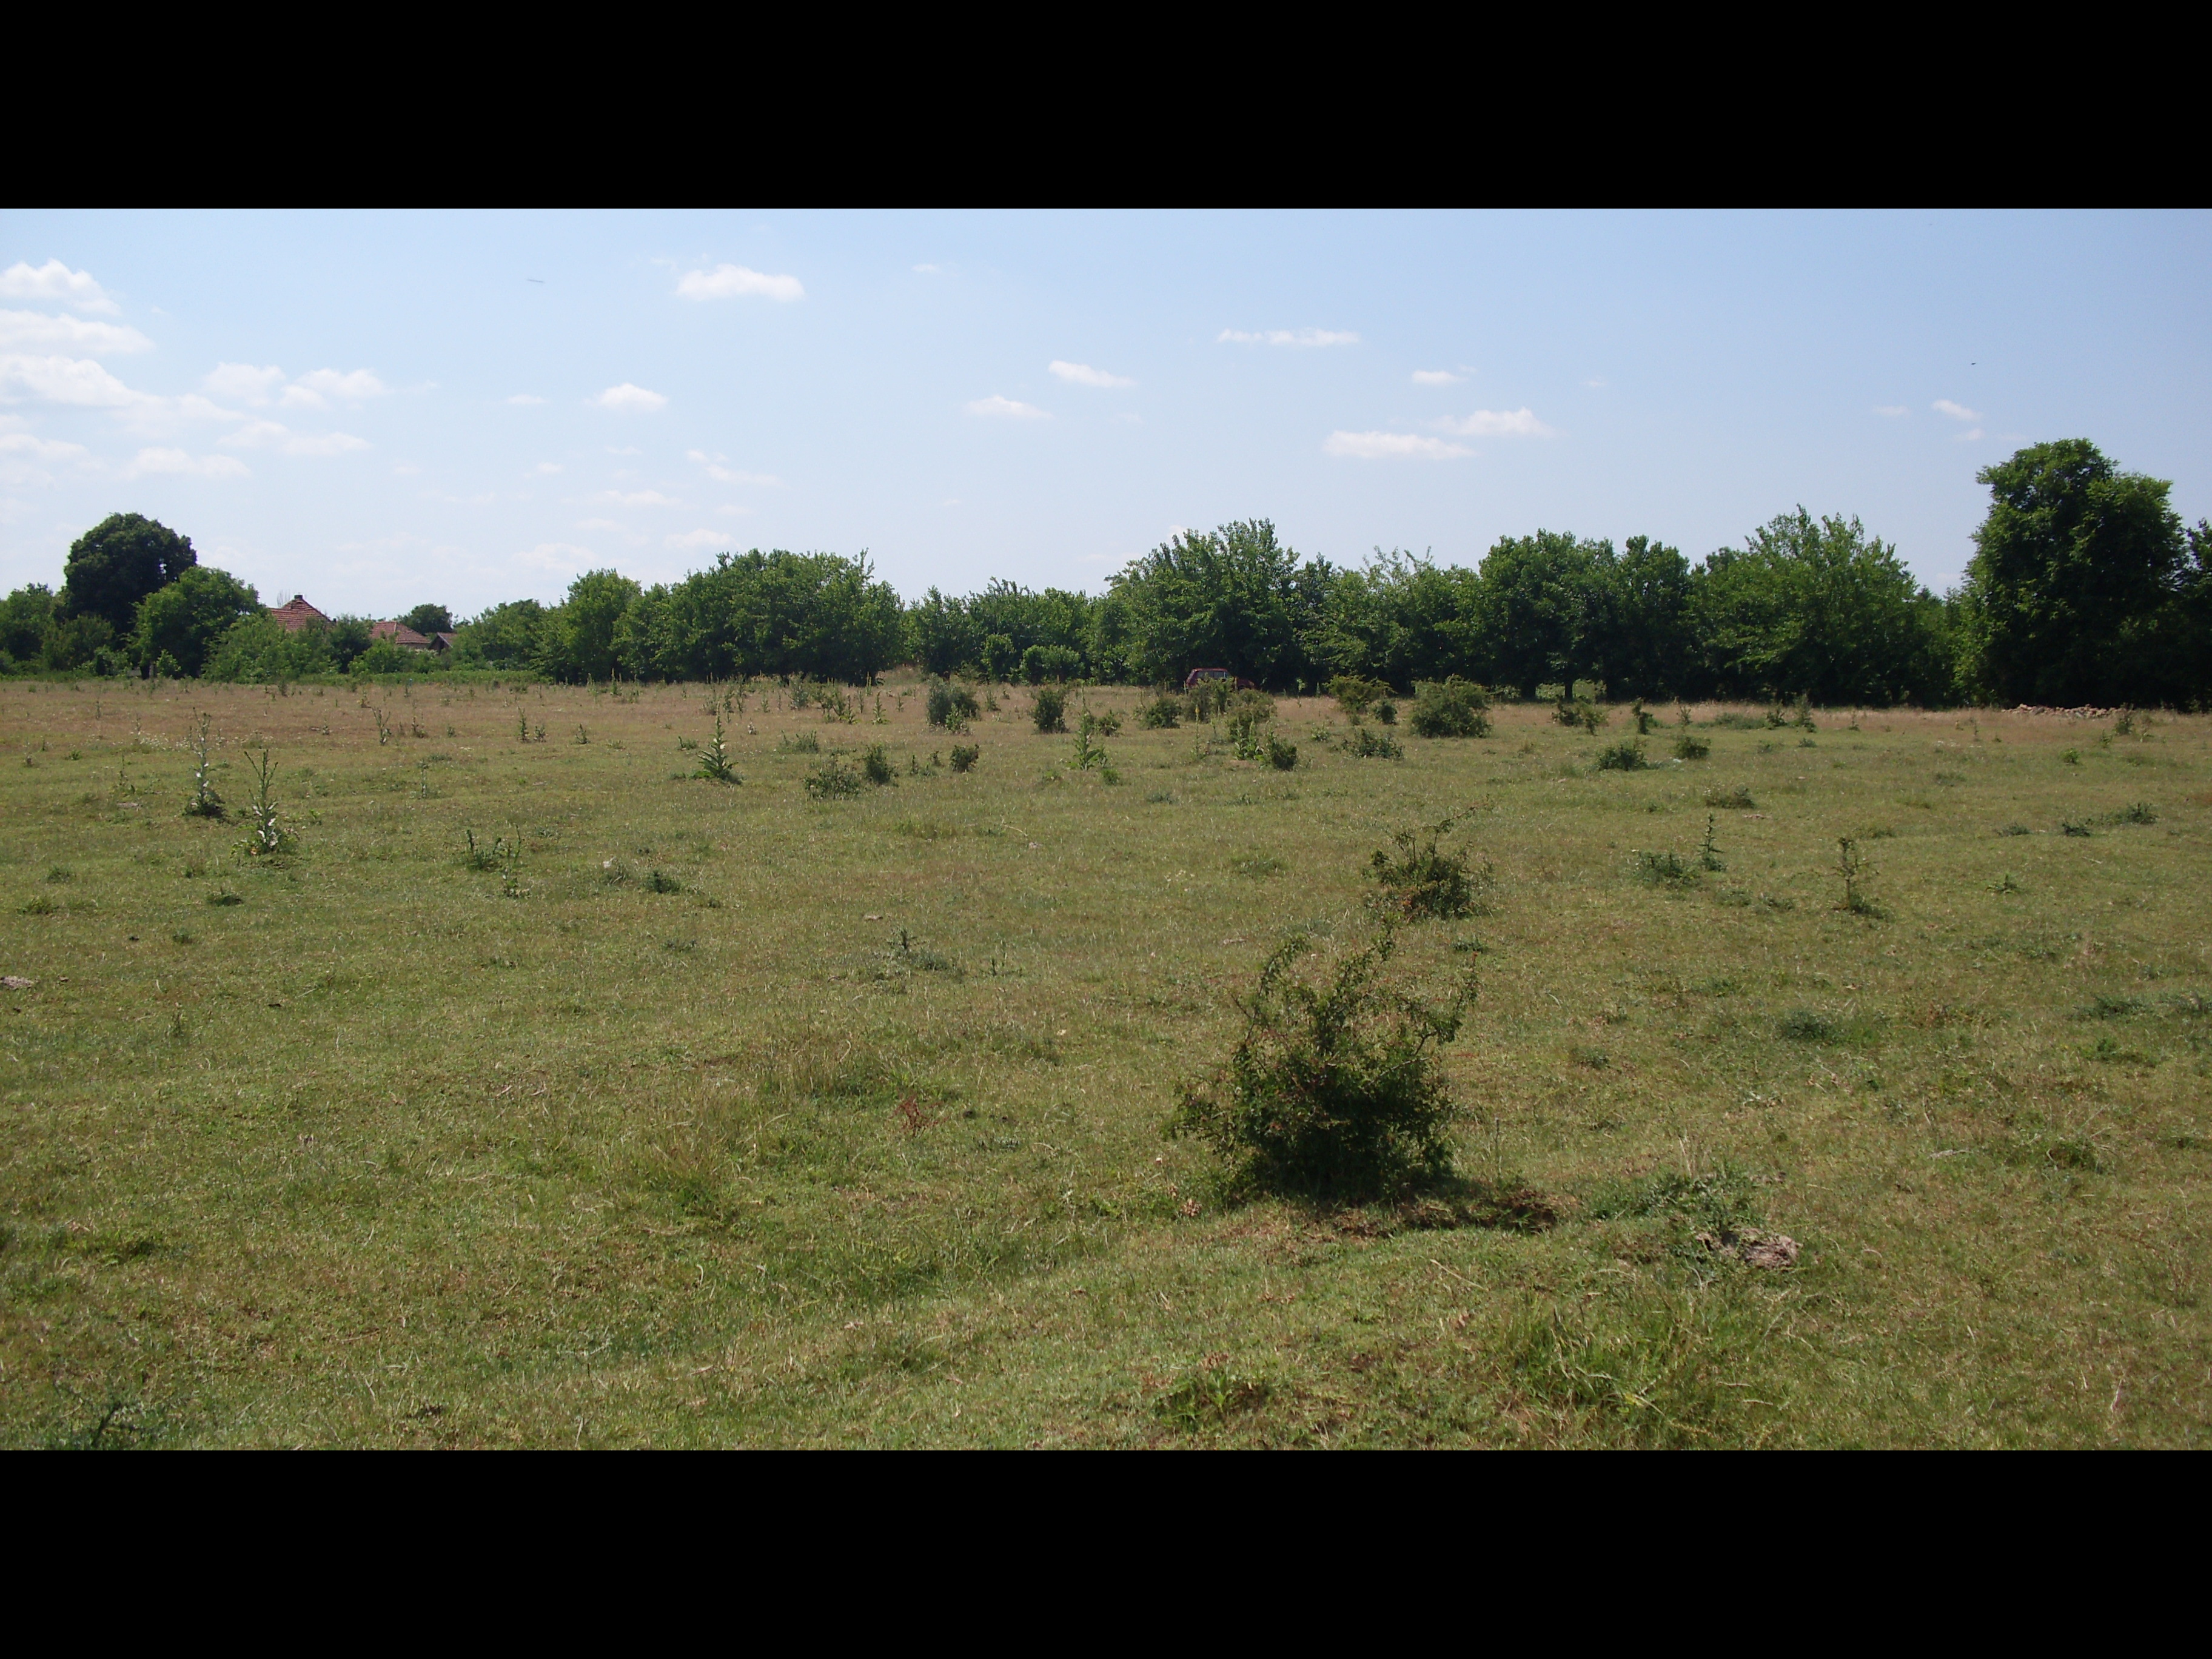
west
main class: Grassland
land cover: Grassland with sparse tree/shrub cover
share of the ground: > 75 %
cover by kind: herbaceous plants 90 %, broadleaved forest trees 5 %, shrubs 5 %
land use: Agriculture (excluding fallow land and kitchen gardens)
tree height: < 5 m
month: June
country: BG
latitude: 43.5308
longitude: 23.5454
